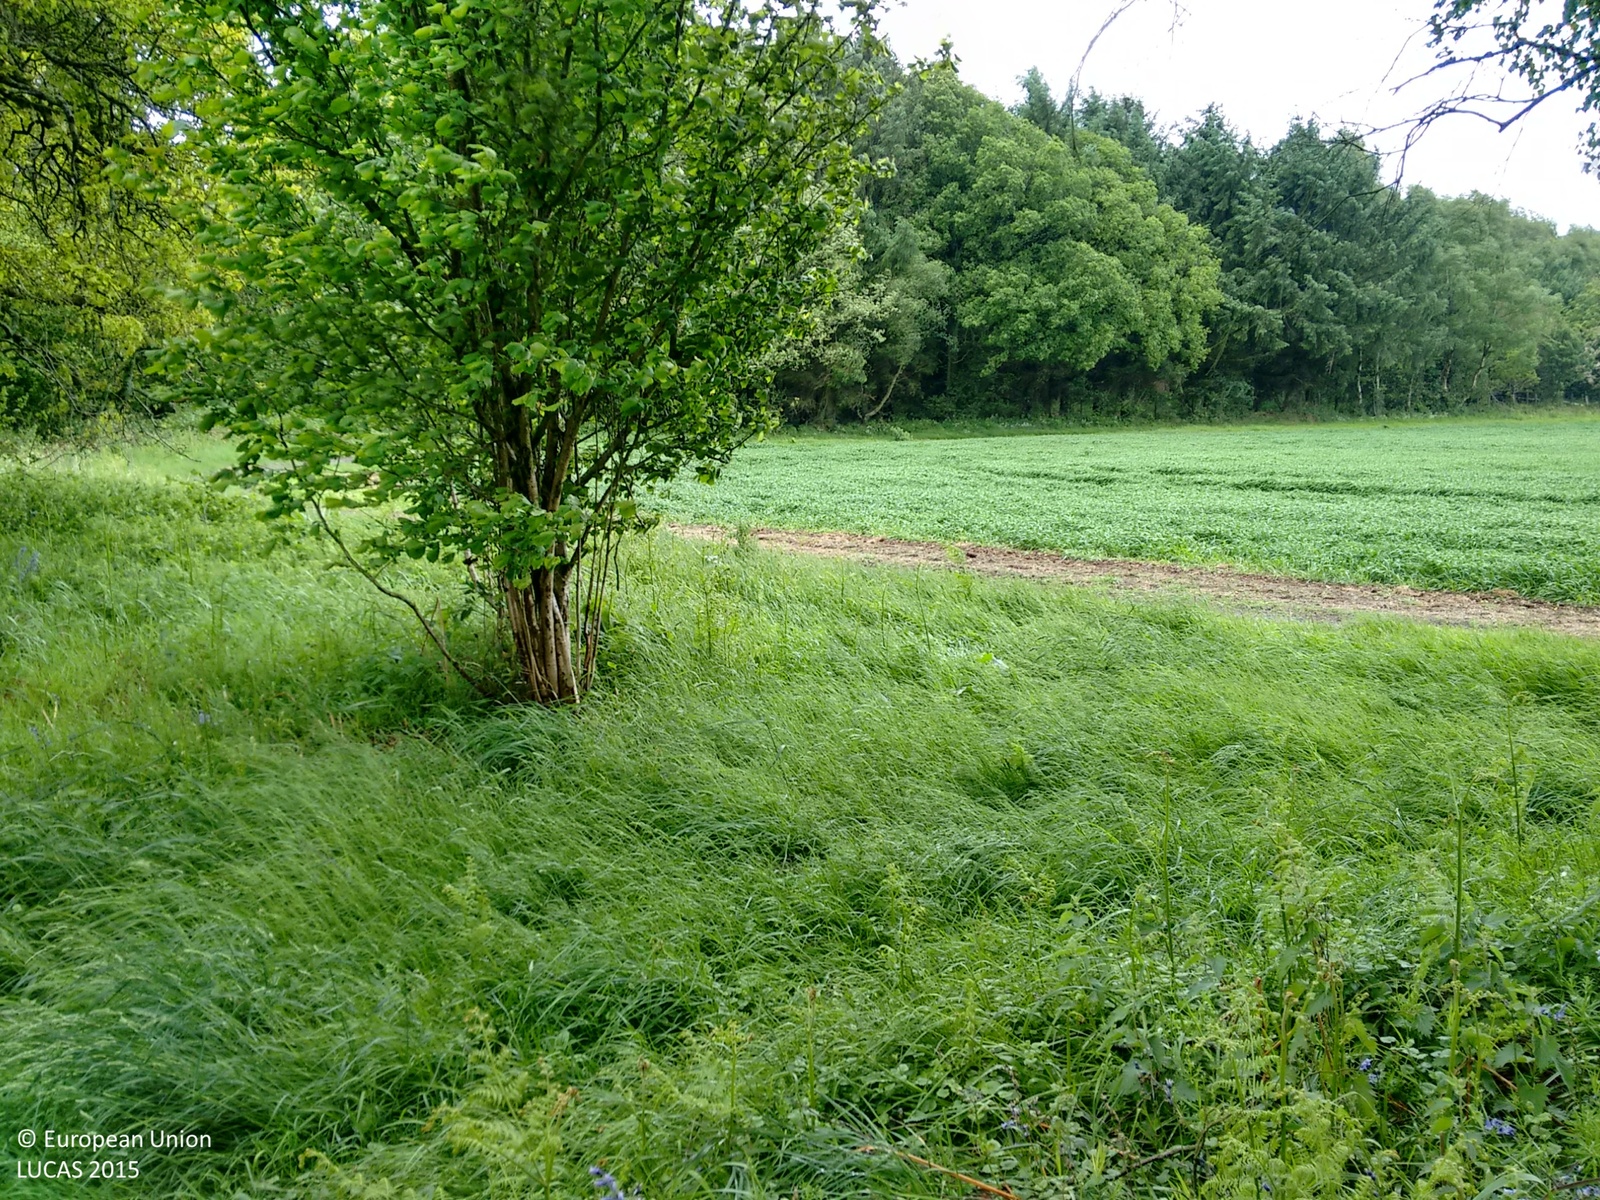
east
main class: Woodland
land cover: Broadleaved woodland
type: mesophytic deciduous forest
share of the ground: > 75 %
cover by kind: broadleaved forest trees 90 %, herbaceous plants 10 %
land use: Amenities, museums, leisure
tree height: > 5 m
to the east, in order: Broadleaved woodland; Tracks; Barley; Grass margins; Tracks; Broadleaved woodland; Fences; Paved roads, cycling and walking lanes; Broadleaved woodland; Spontaneously vegetated surfaces; Barley
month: June
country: GB
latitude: 51.1953
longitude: -1.1655
